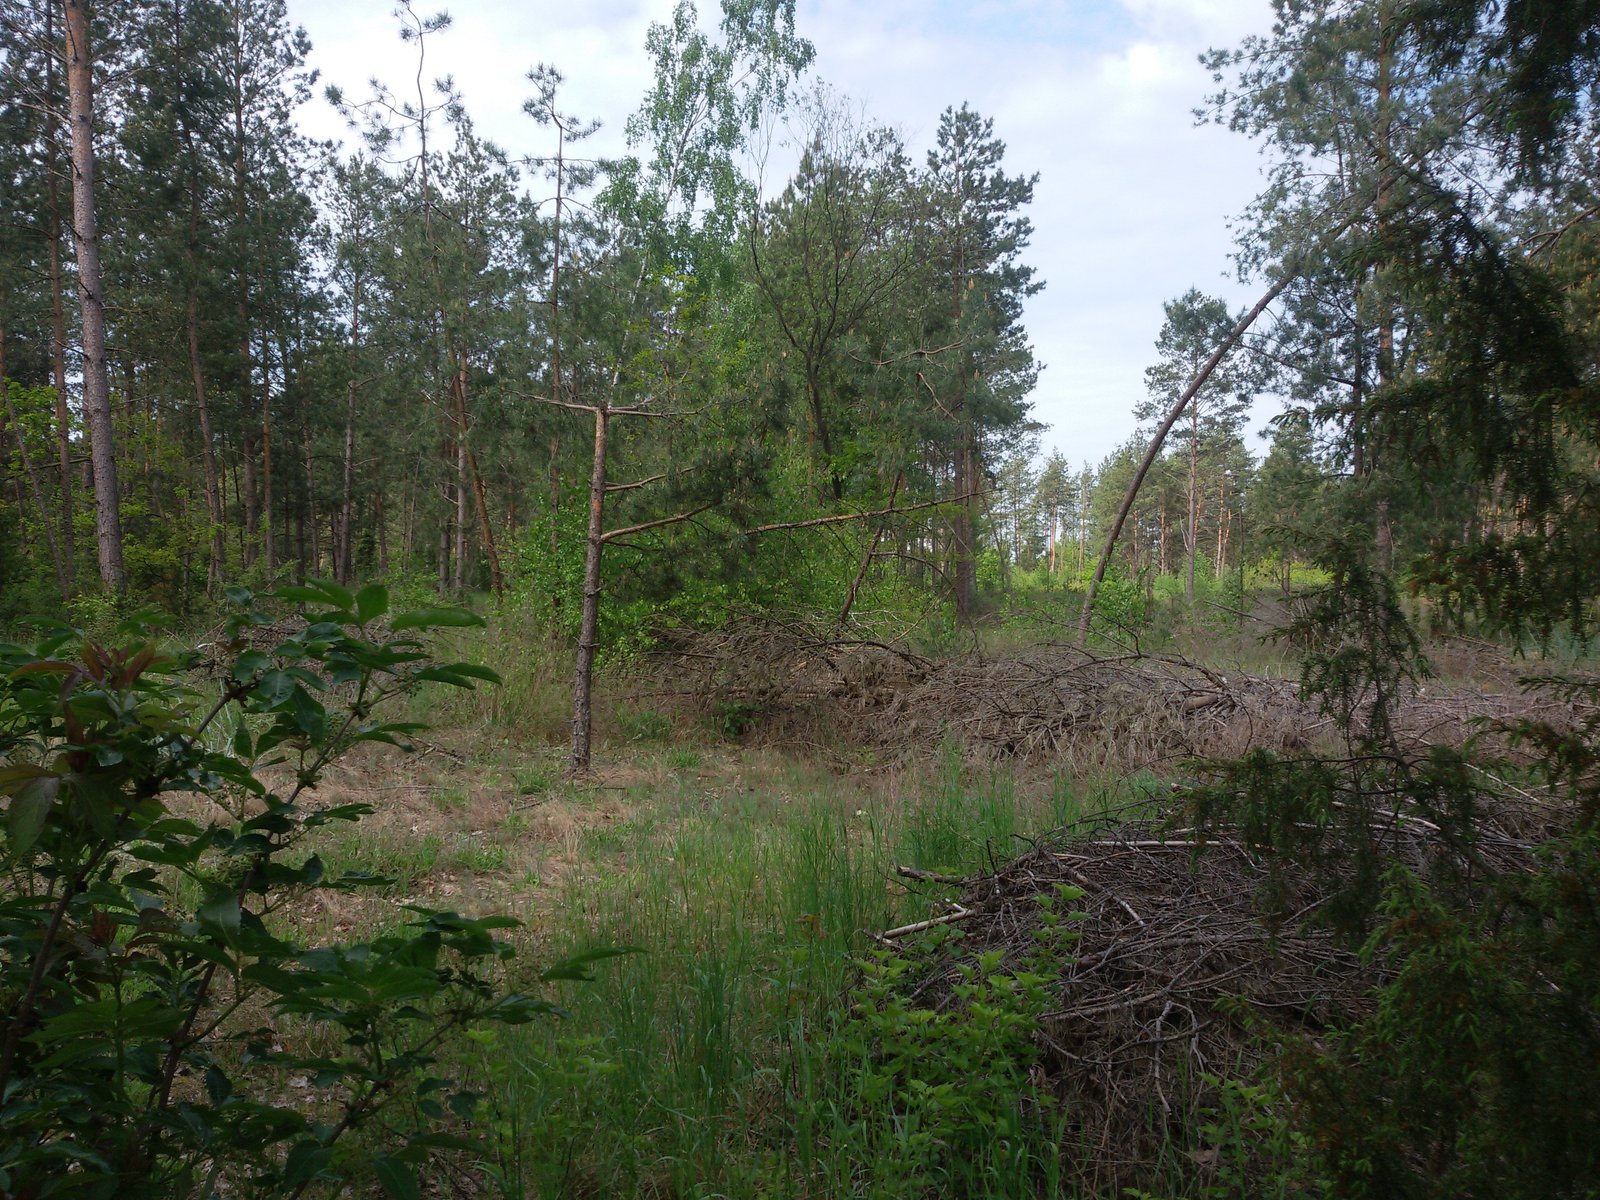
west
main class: Woodland
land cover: Pine dominated mixed woodland
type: hemiboreal forest and nemoral coniferous forest and mixed broadleaved-coniferous forest
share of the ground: > 75 %
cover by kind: coniferous forest trees 60 %, broadleaved forest trees 20 %, herbaceous plants 20 %
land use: Forestry
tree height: > 5 m
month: May
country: PL
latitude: 53.1523
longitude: 21.3986
